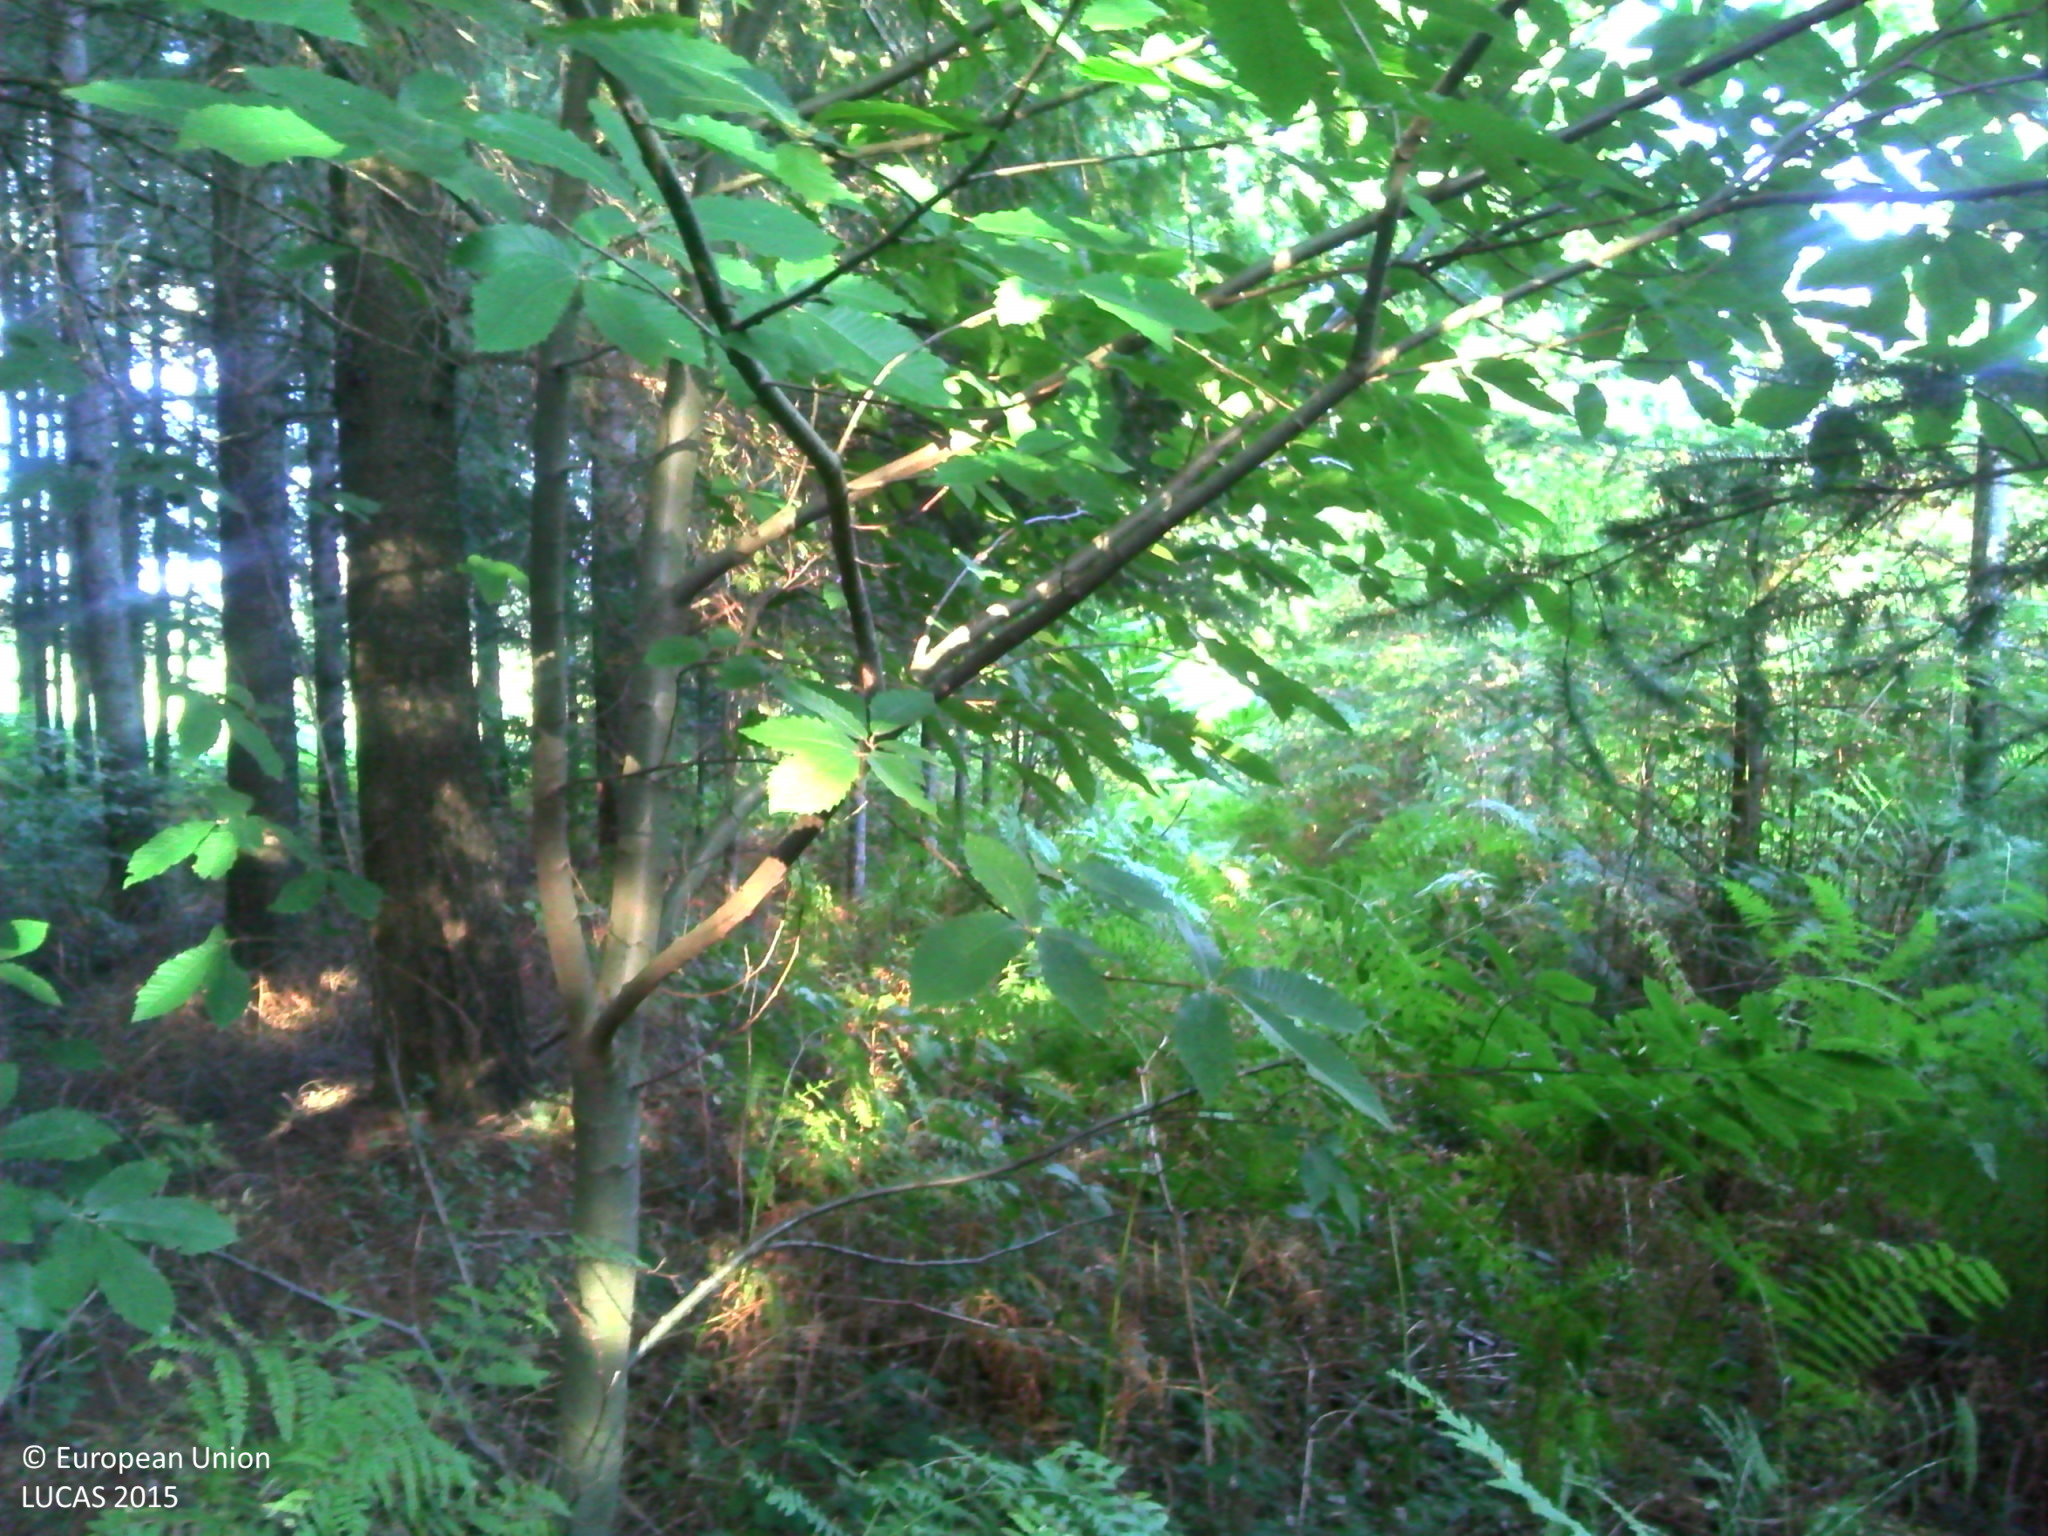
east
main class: Woodland
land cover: Other coniferous woodland
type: exotic forest
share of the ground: > 75 %
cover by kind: coniferous forest trees 70 %, herbaceous plants 15 %, broadleaved forest trees 5 %, shrubs 5 %, lichens and mosses 5 %
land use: Forestry
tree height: > 5 m
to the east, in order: Other coniferous woodland; Grass margins; Paved roads, cycling and walking lanes; Grass margins; Shrubland with sparse tree cover; Other bare soil; Shruby margins; Ditches and canals; Paved roads, cycling and walking lanes; Grass margins; Electric lines; Broadleaved woodland; Grassland without tree/shrub cover; Broadleaved woodland
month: August
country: FR
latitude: 45.8860
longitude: 1.7335
